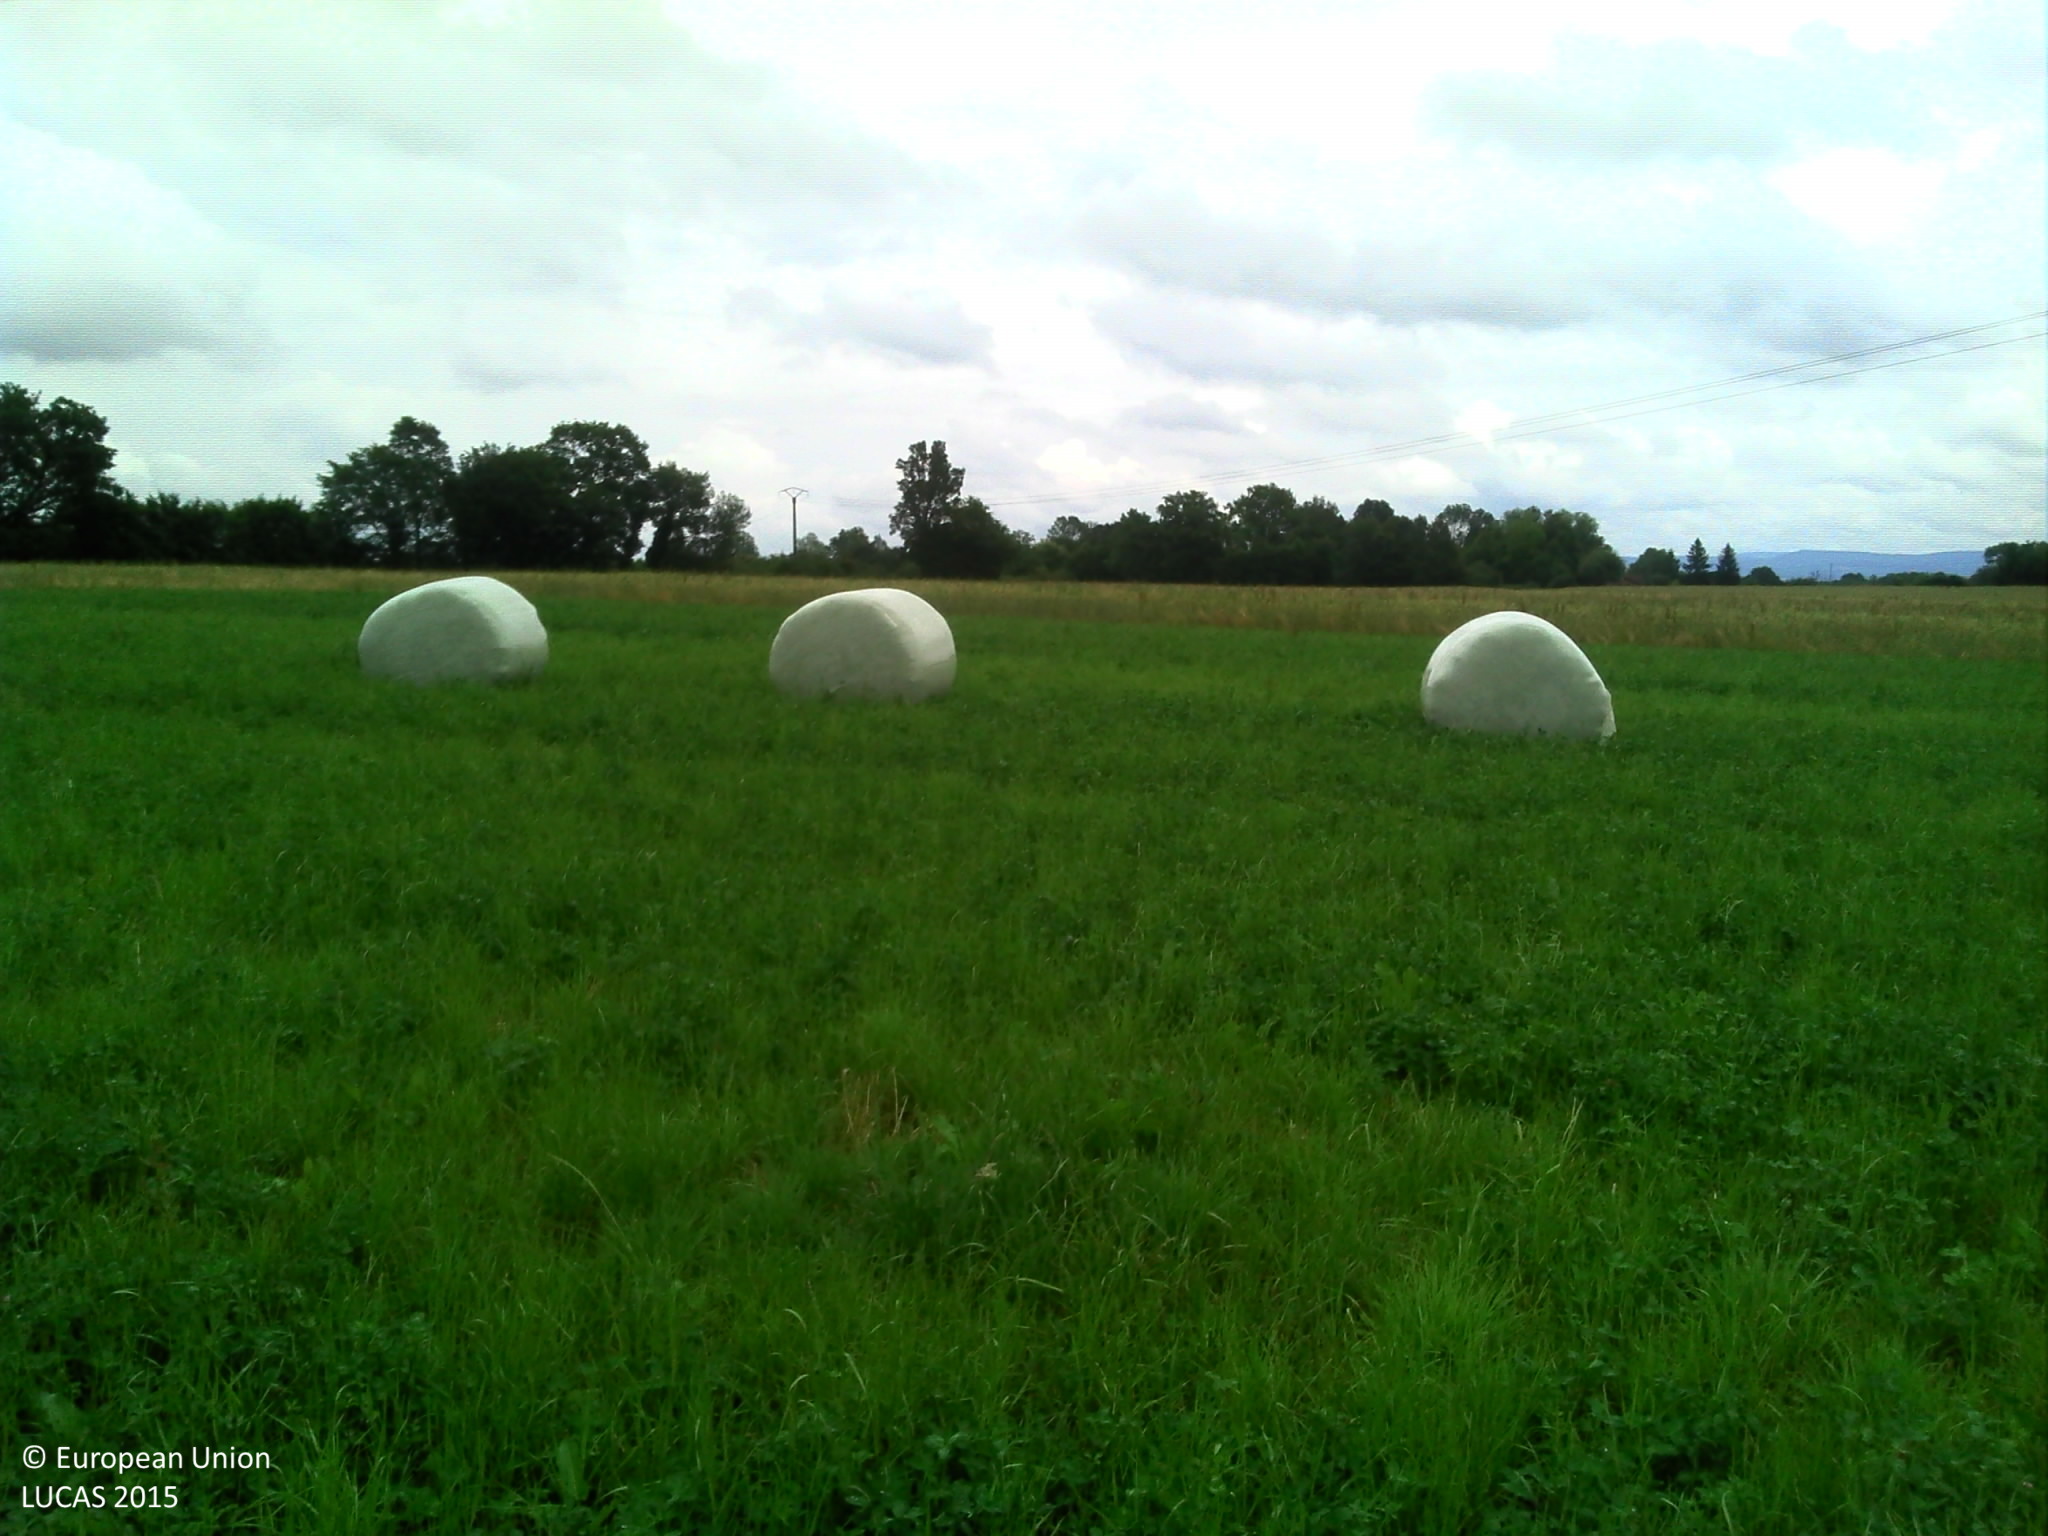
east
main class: Cropland
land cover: Clovers
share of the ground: 50 - 75 %
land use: Agriculture (excluding fallow land and kitchen gardens)
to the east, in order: Clovers; Common wheat; Ditches and canals; Broadleaved woodland; Maize
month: June
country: FR
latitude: 46.6633
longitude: 5.3102
